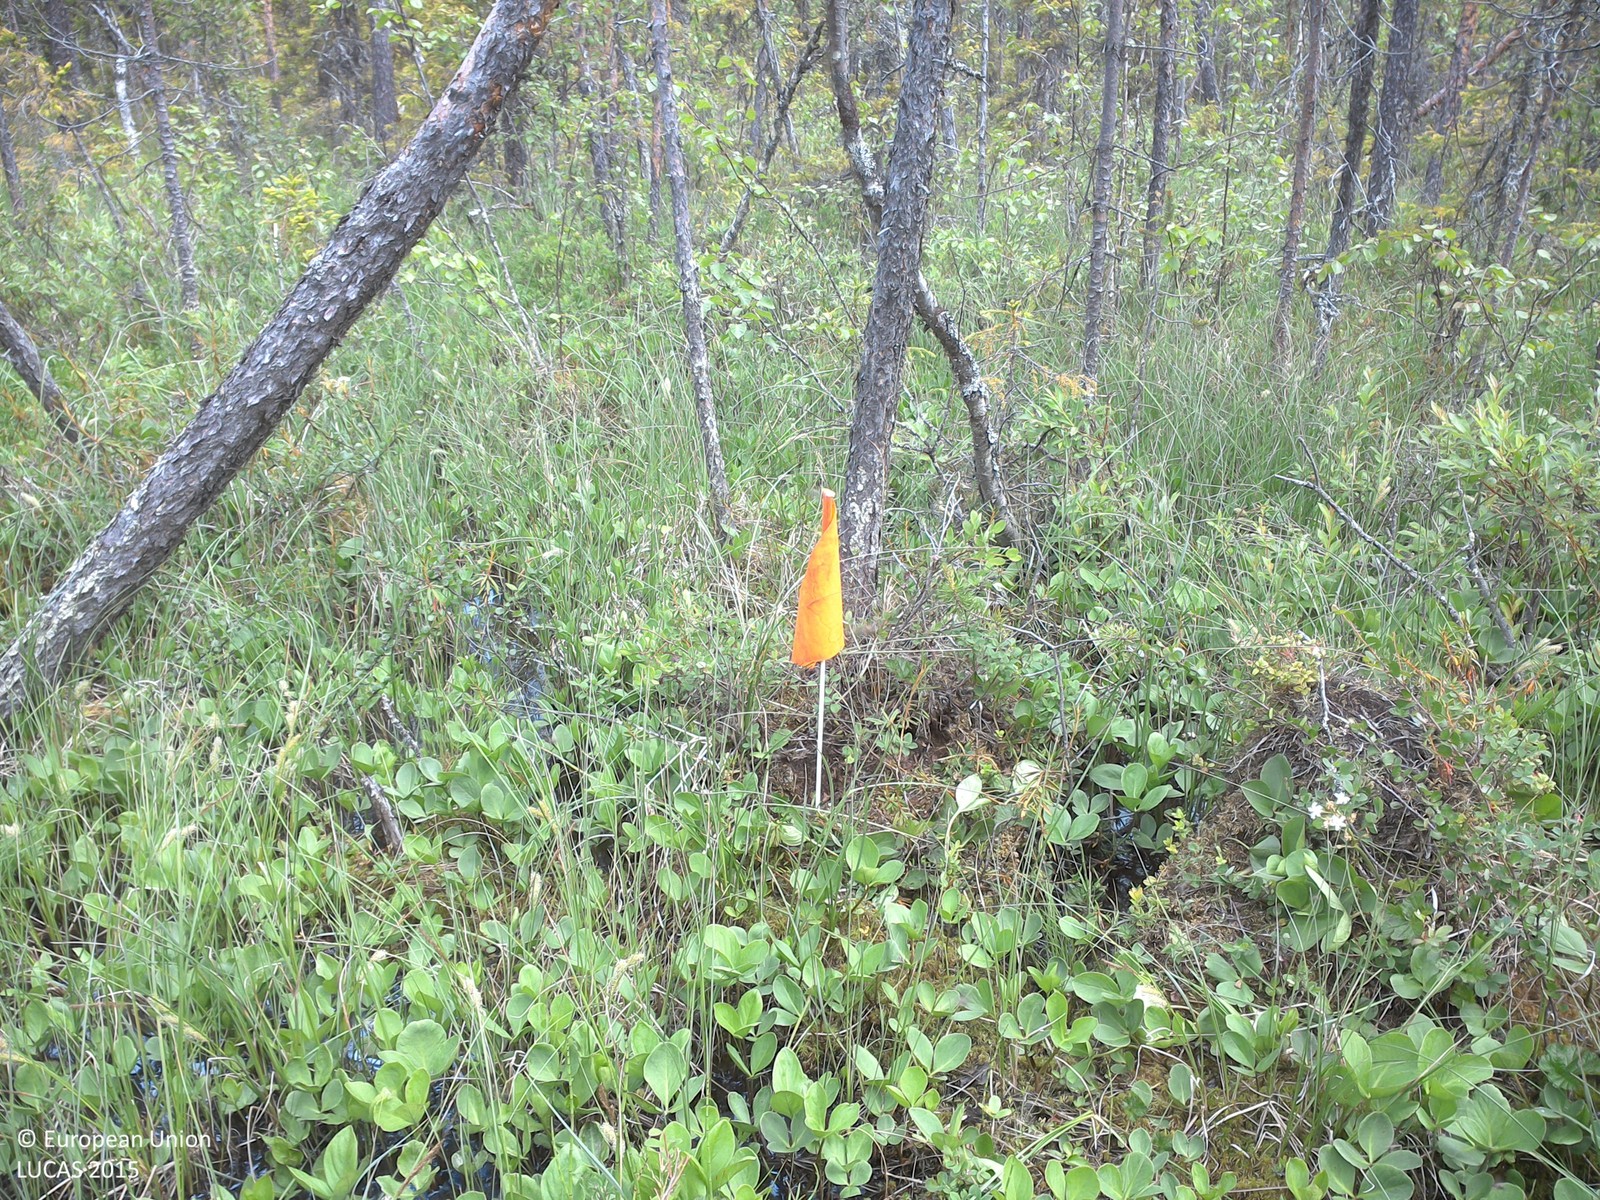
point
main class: Woodland
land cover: Pine dominated mixed woodland
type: boreal forest
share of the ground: 10 - 25 %
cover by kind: herbaceous plants 50 %, coniferous forest trees 15 %, shrubs 15 %, lichens and mosses 10 %, broadleaved forest trees 5 %
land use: Forestry
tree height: > 5 m
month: July
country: SE
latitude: 67.2988
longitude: 22.7575
